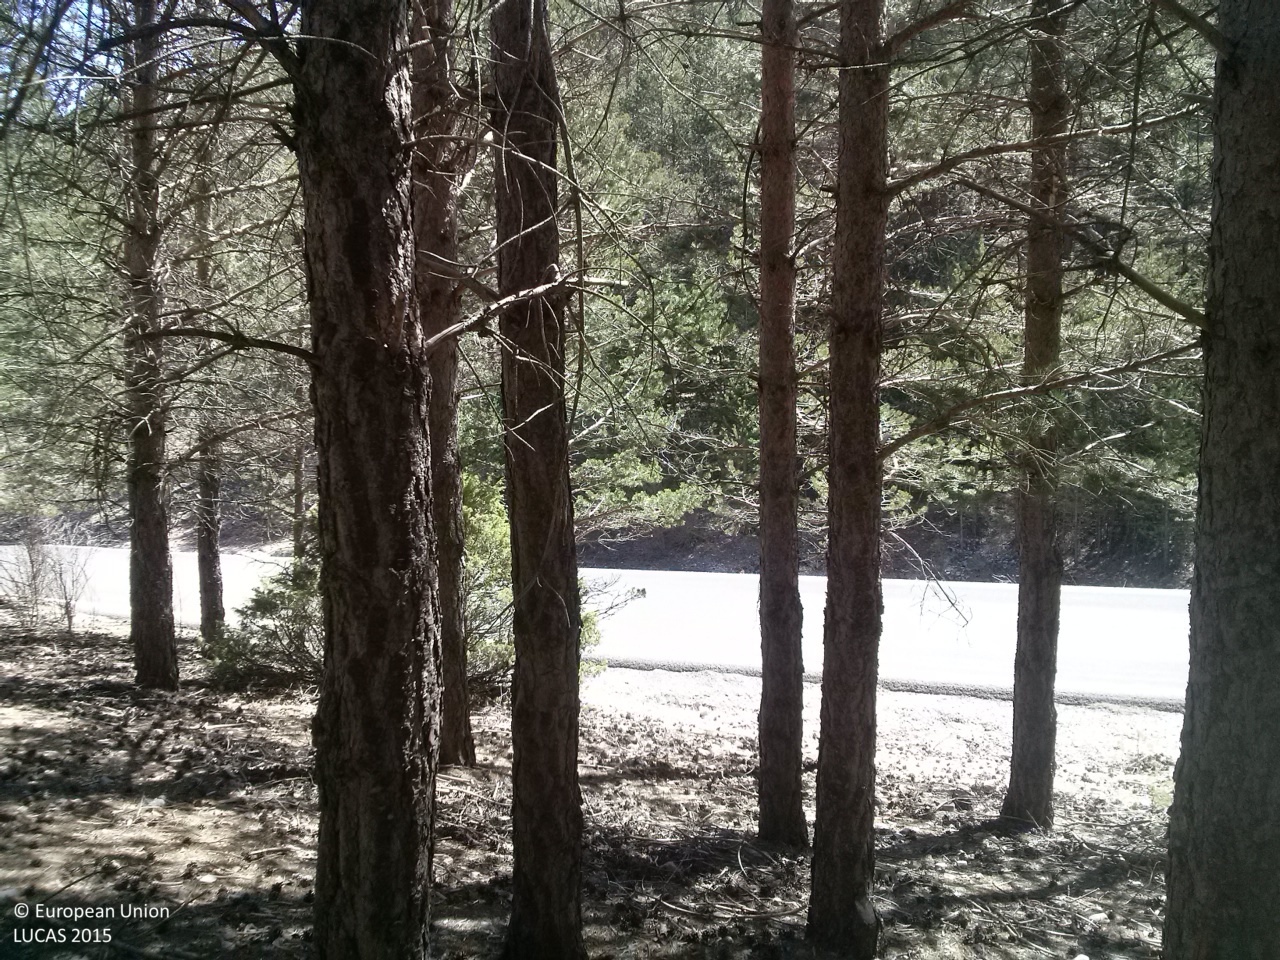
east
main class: Woodland
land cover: Pine dominated coniferous woodland
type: coniferous forest of the mediterranean region
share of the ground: > 75 %
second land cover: Grassland without tree/shrub cover
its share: 50 - 75 %
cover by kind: coniferous forest trees 75 %, herbaceous plants 15 %, shrubs 5 %, unconsolidated bare surface 5 %
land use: Forestry
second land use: Agriculture (excluding fallow land and kitchen gardens)
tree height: > 5 m
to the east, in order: Pine dominated coniferous woodland; Grassland without tree/shrub cover; Grass margins; Paved roads, cycling and walking lanes; Grass margins; Pine dominated coniferous woodland
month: April
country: ES
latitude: 40.3436
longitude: -1.7527
